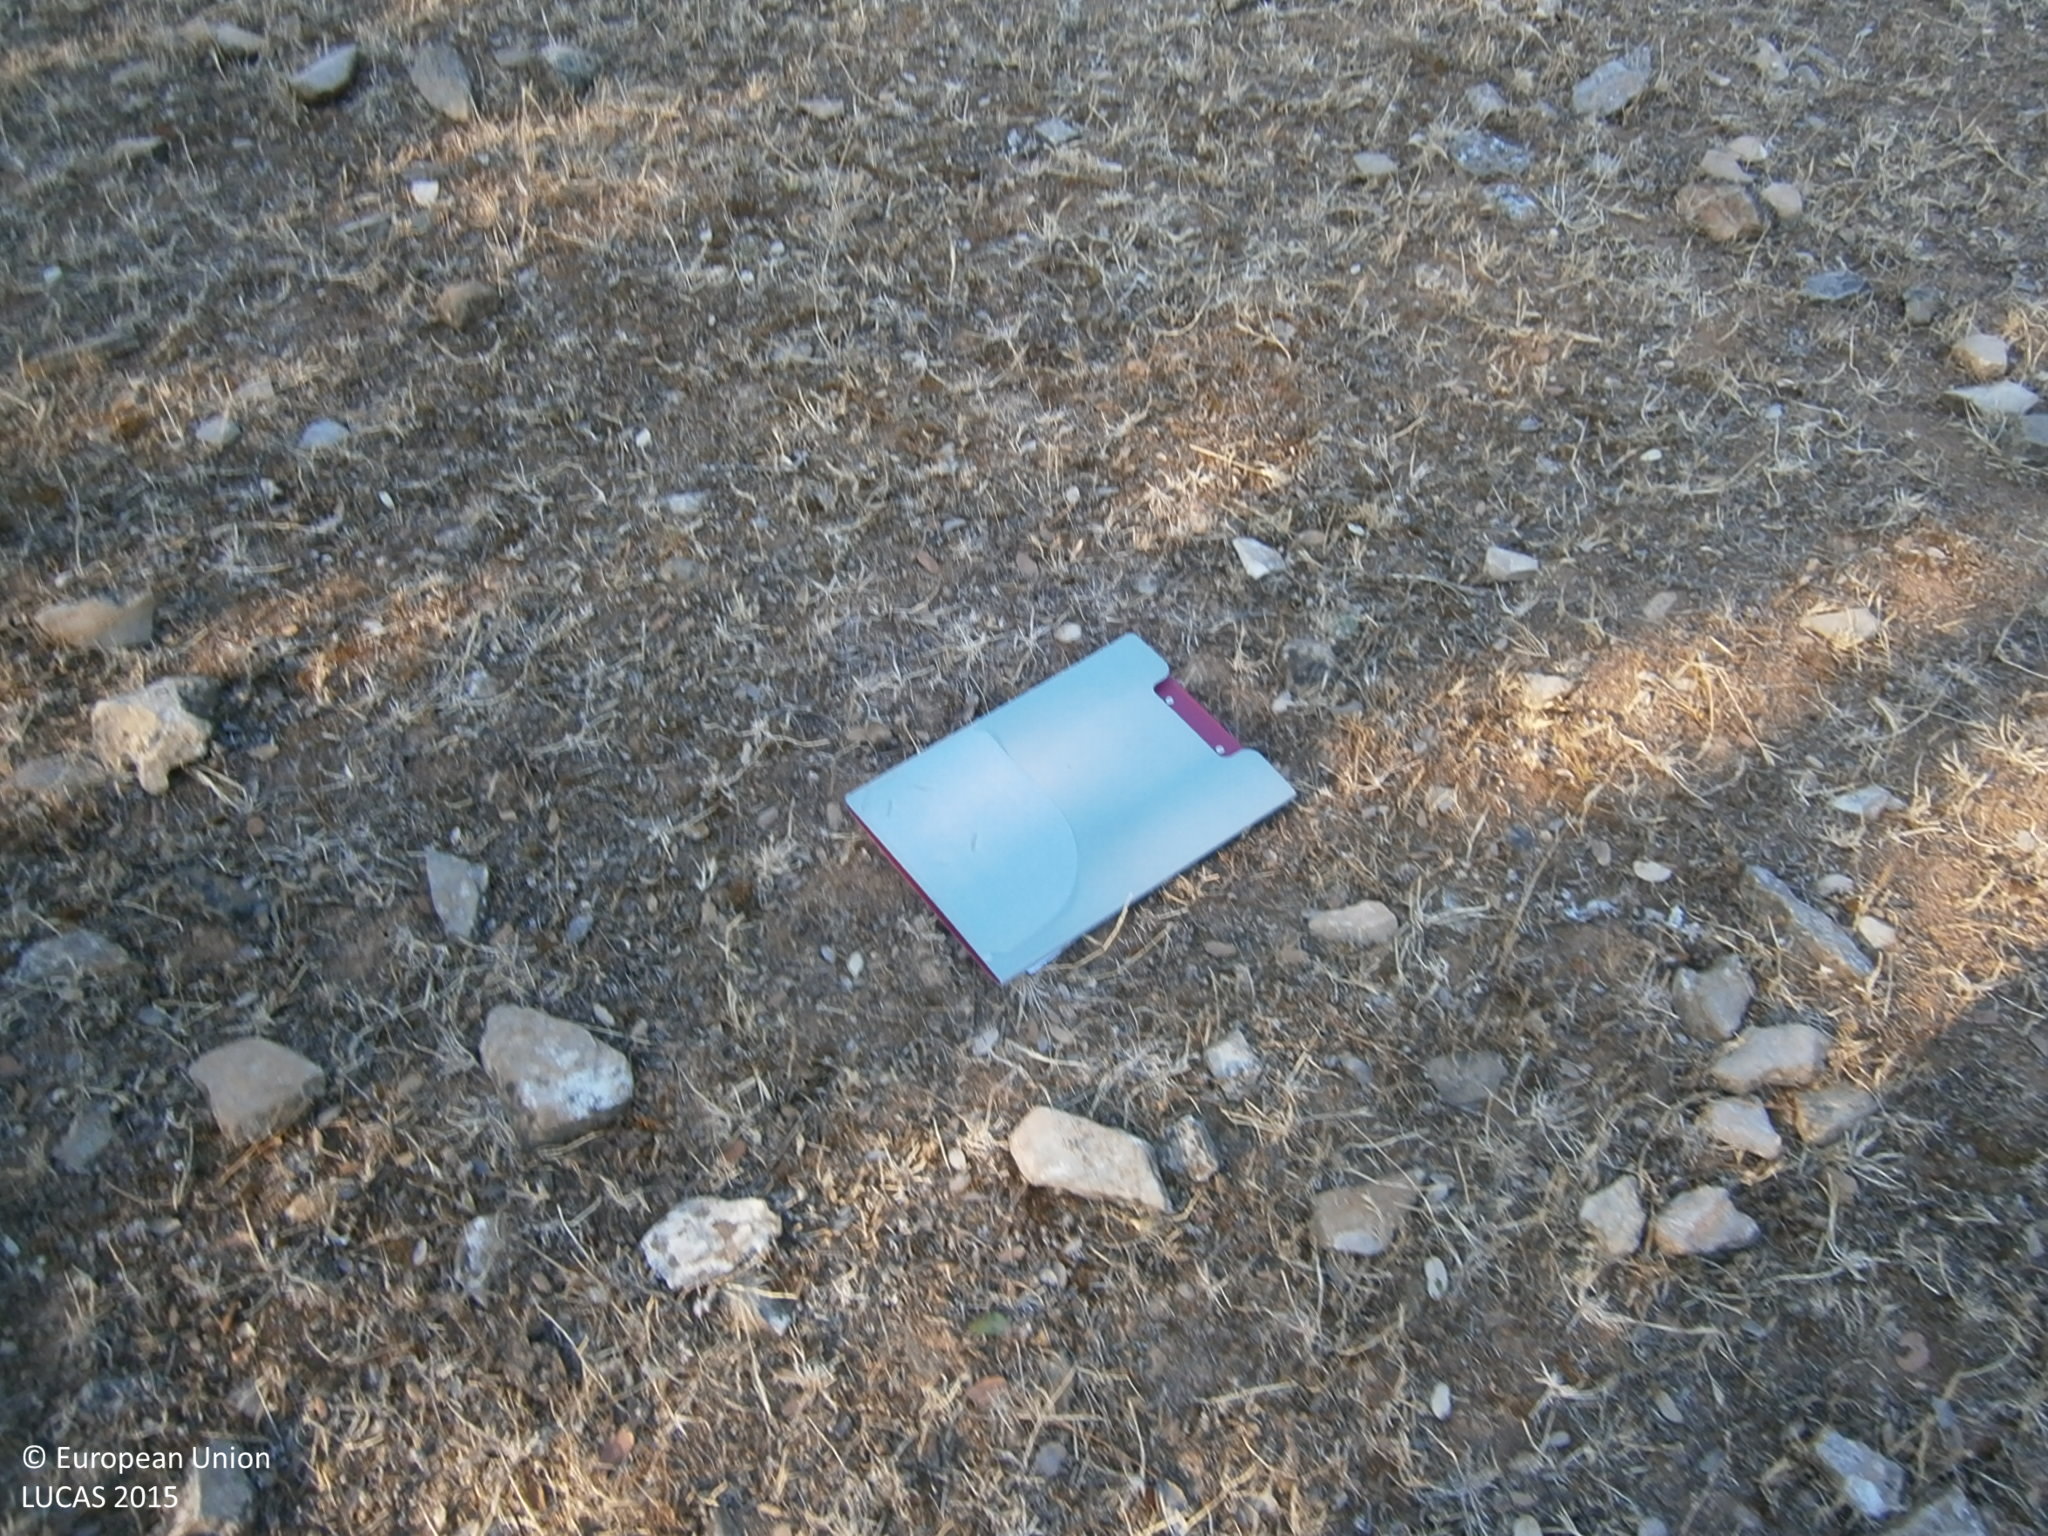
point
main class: Woodland
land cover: Broadleaved woodland
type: broadleaved evergreen forest
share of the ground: > 75 %
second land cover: Spontaneously vegetated surfaces
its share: 50 - 75 %
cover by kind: herbaceous plants 70 %, broadleaved forest trees 10 %, unconsolidated bare surface 10 %, shrubs 5 %
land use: Forestry
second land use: Agriculture (excluding fallow land and kitchen gardens)
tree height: > 5 m
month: June
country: ES
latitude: 38.5839
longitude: -6.8100
